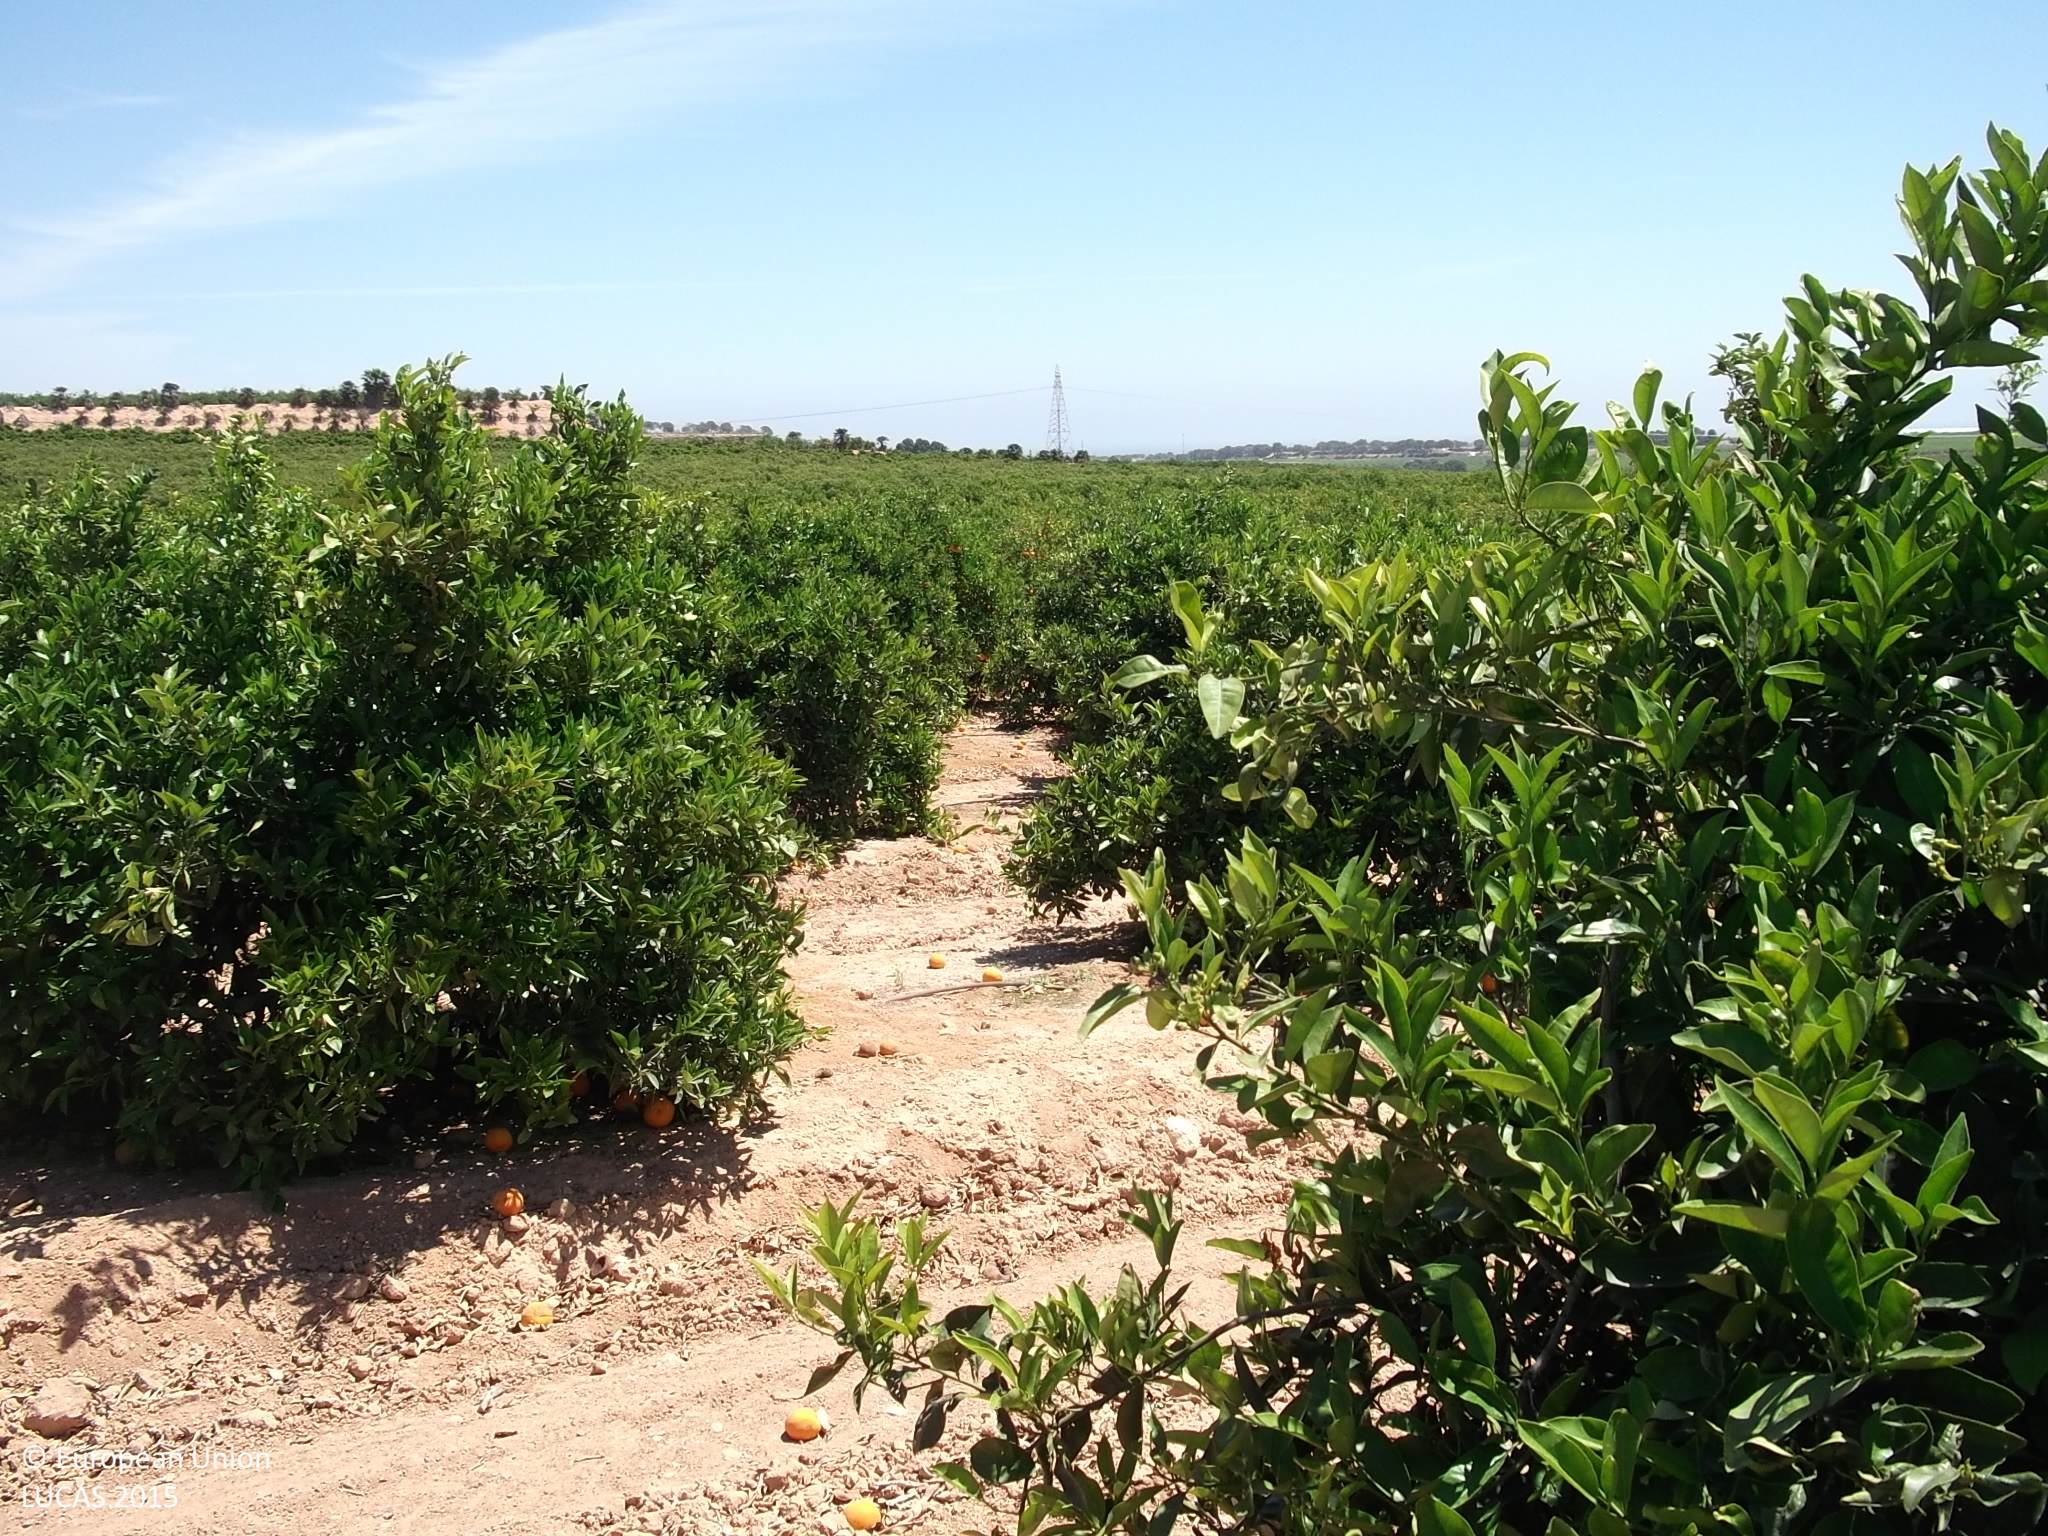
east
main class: Cropland
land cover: Oranges
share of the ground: 10 - 25 %
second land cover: Other bare soil
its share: > 75 %
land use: Agriculture (excluding fallow land and kitchen gardens)
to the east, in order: Oranges; Other bare soil; Tracks; Oranges; Tracks; Other citrus fruit; Tracks; Other citrus fruit
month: May
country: ES
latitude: 37.8962
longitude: -0.8189
